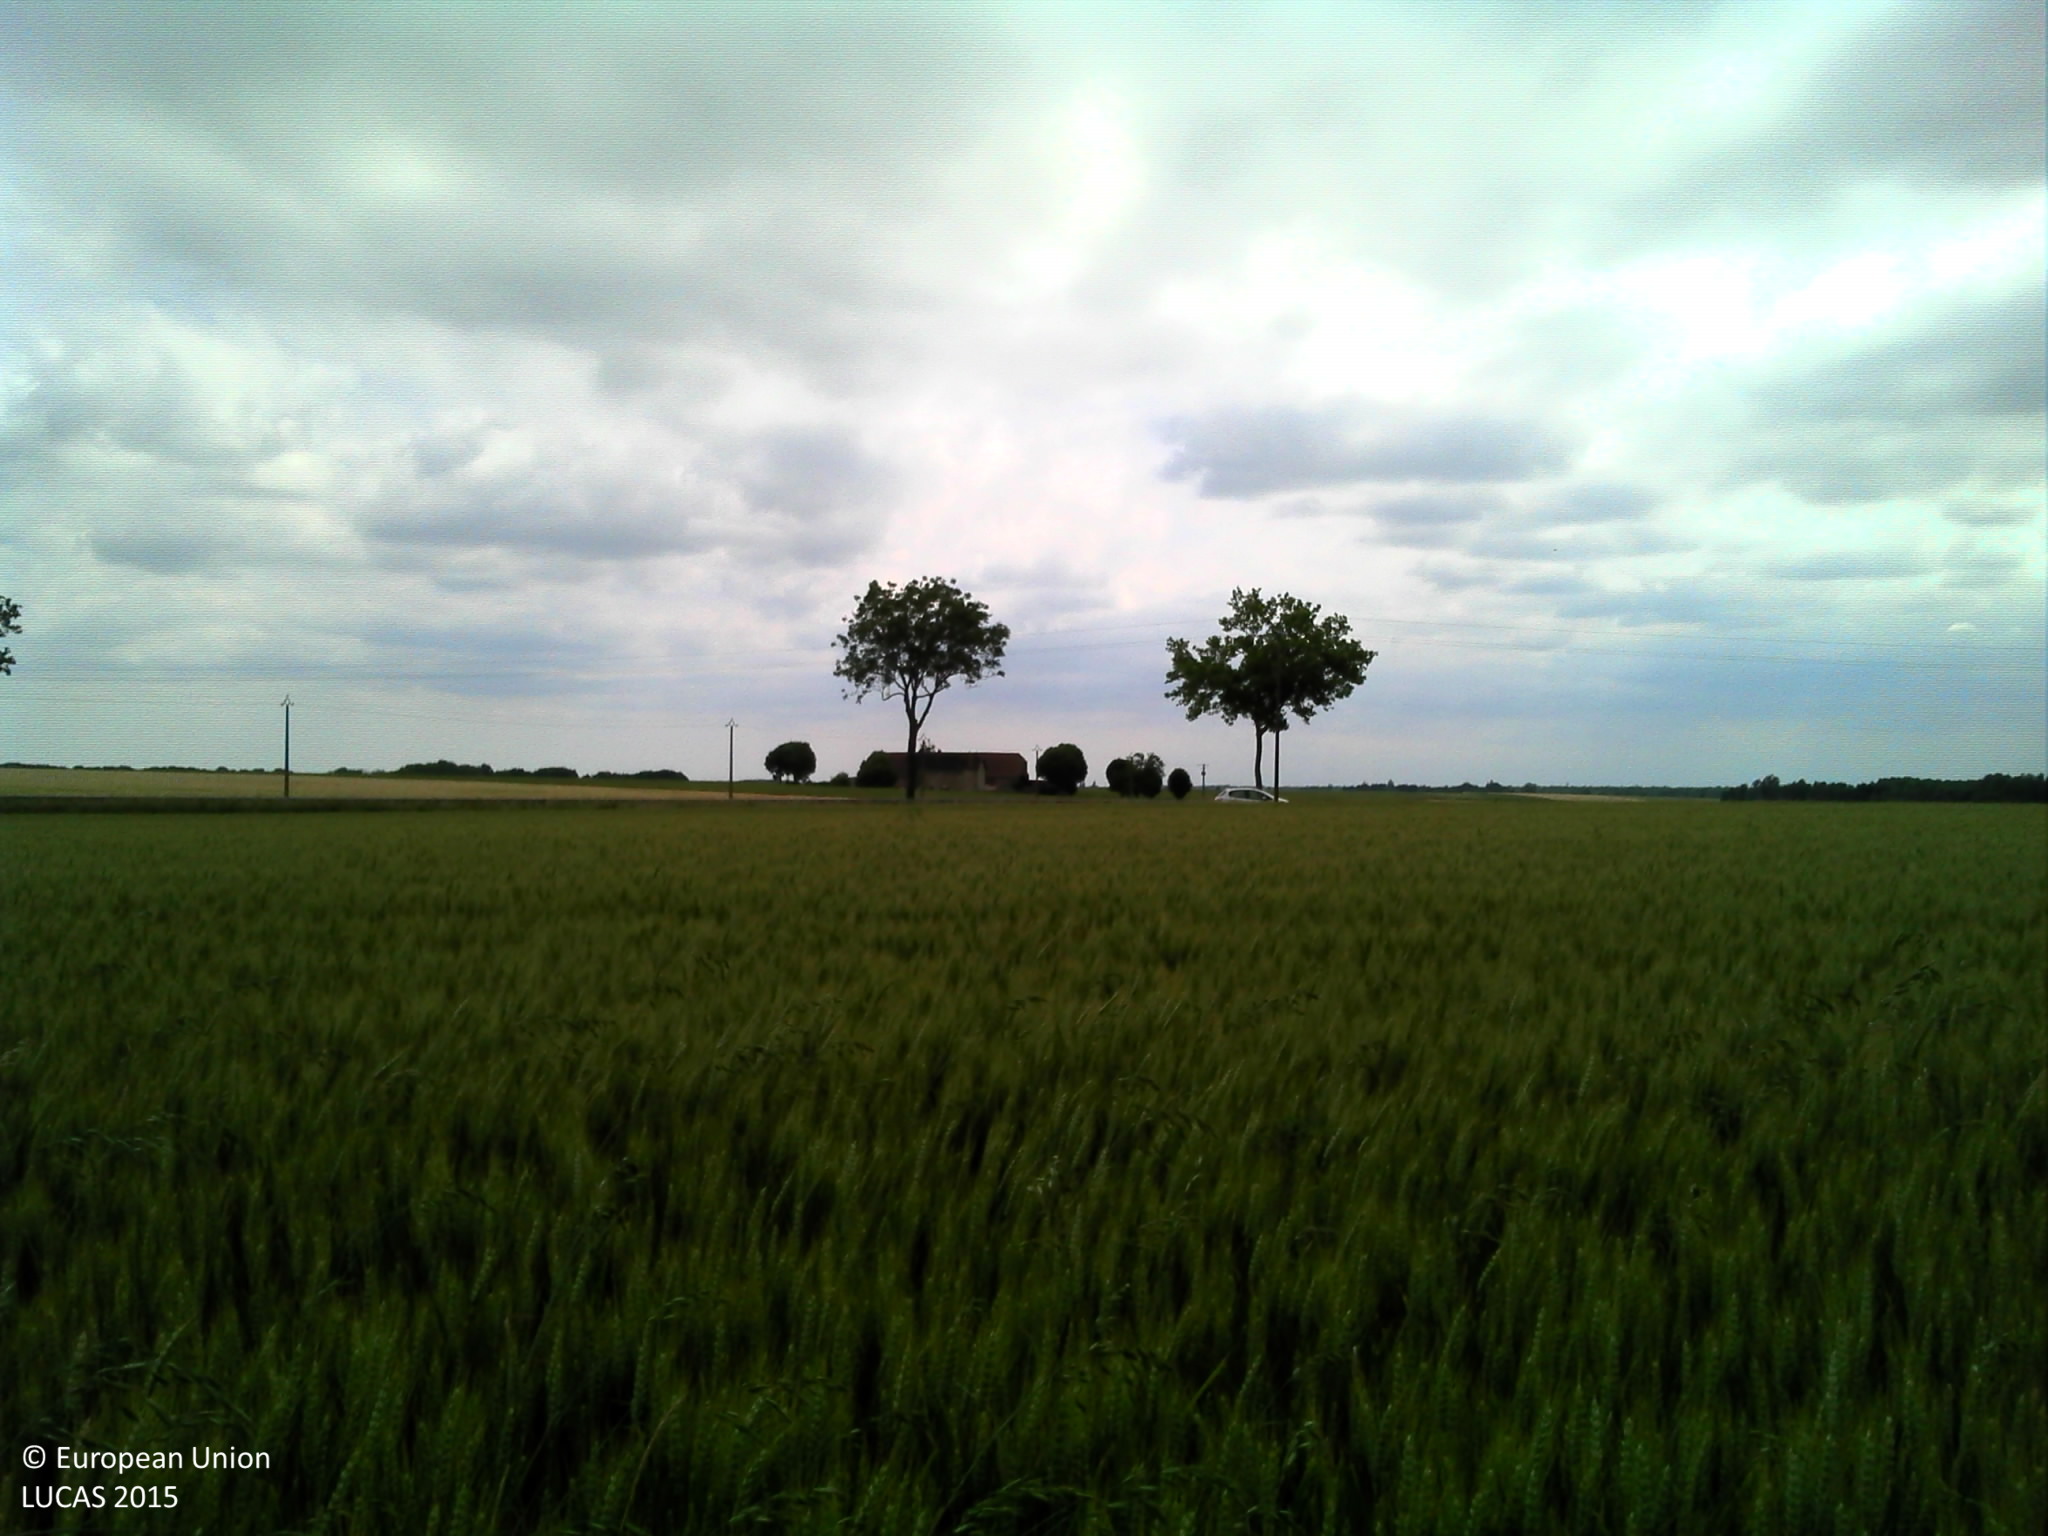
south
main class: Cropland
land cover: Rape and turnip rape
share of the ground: > 75 %
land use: Agriculture (excluding fallow land and kitchen gardens)
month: June
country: FR
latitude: 47.3448
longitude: 5.2224
